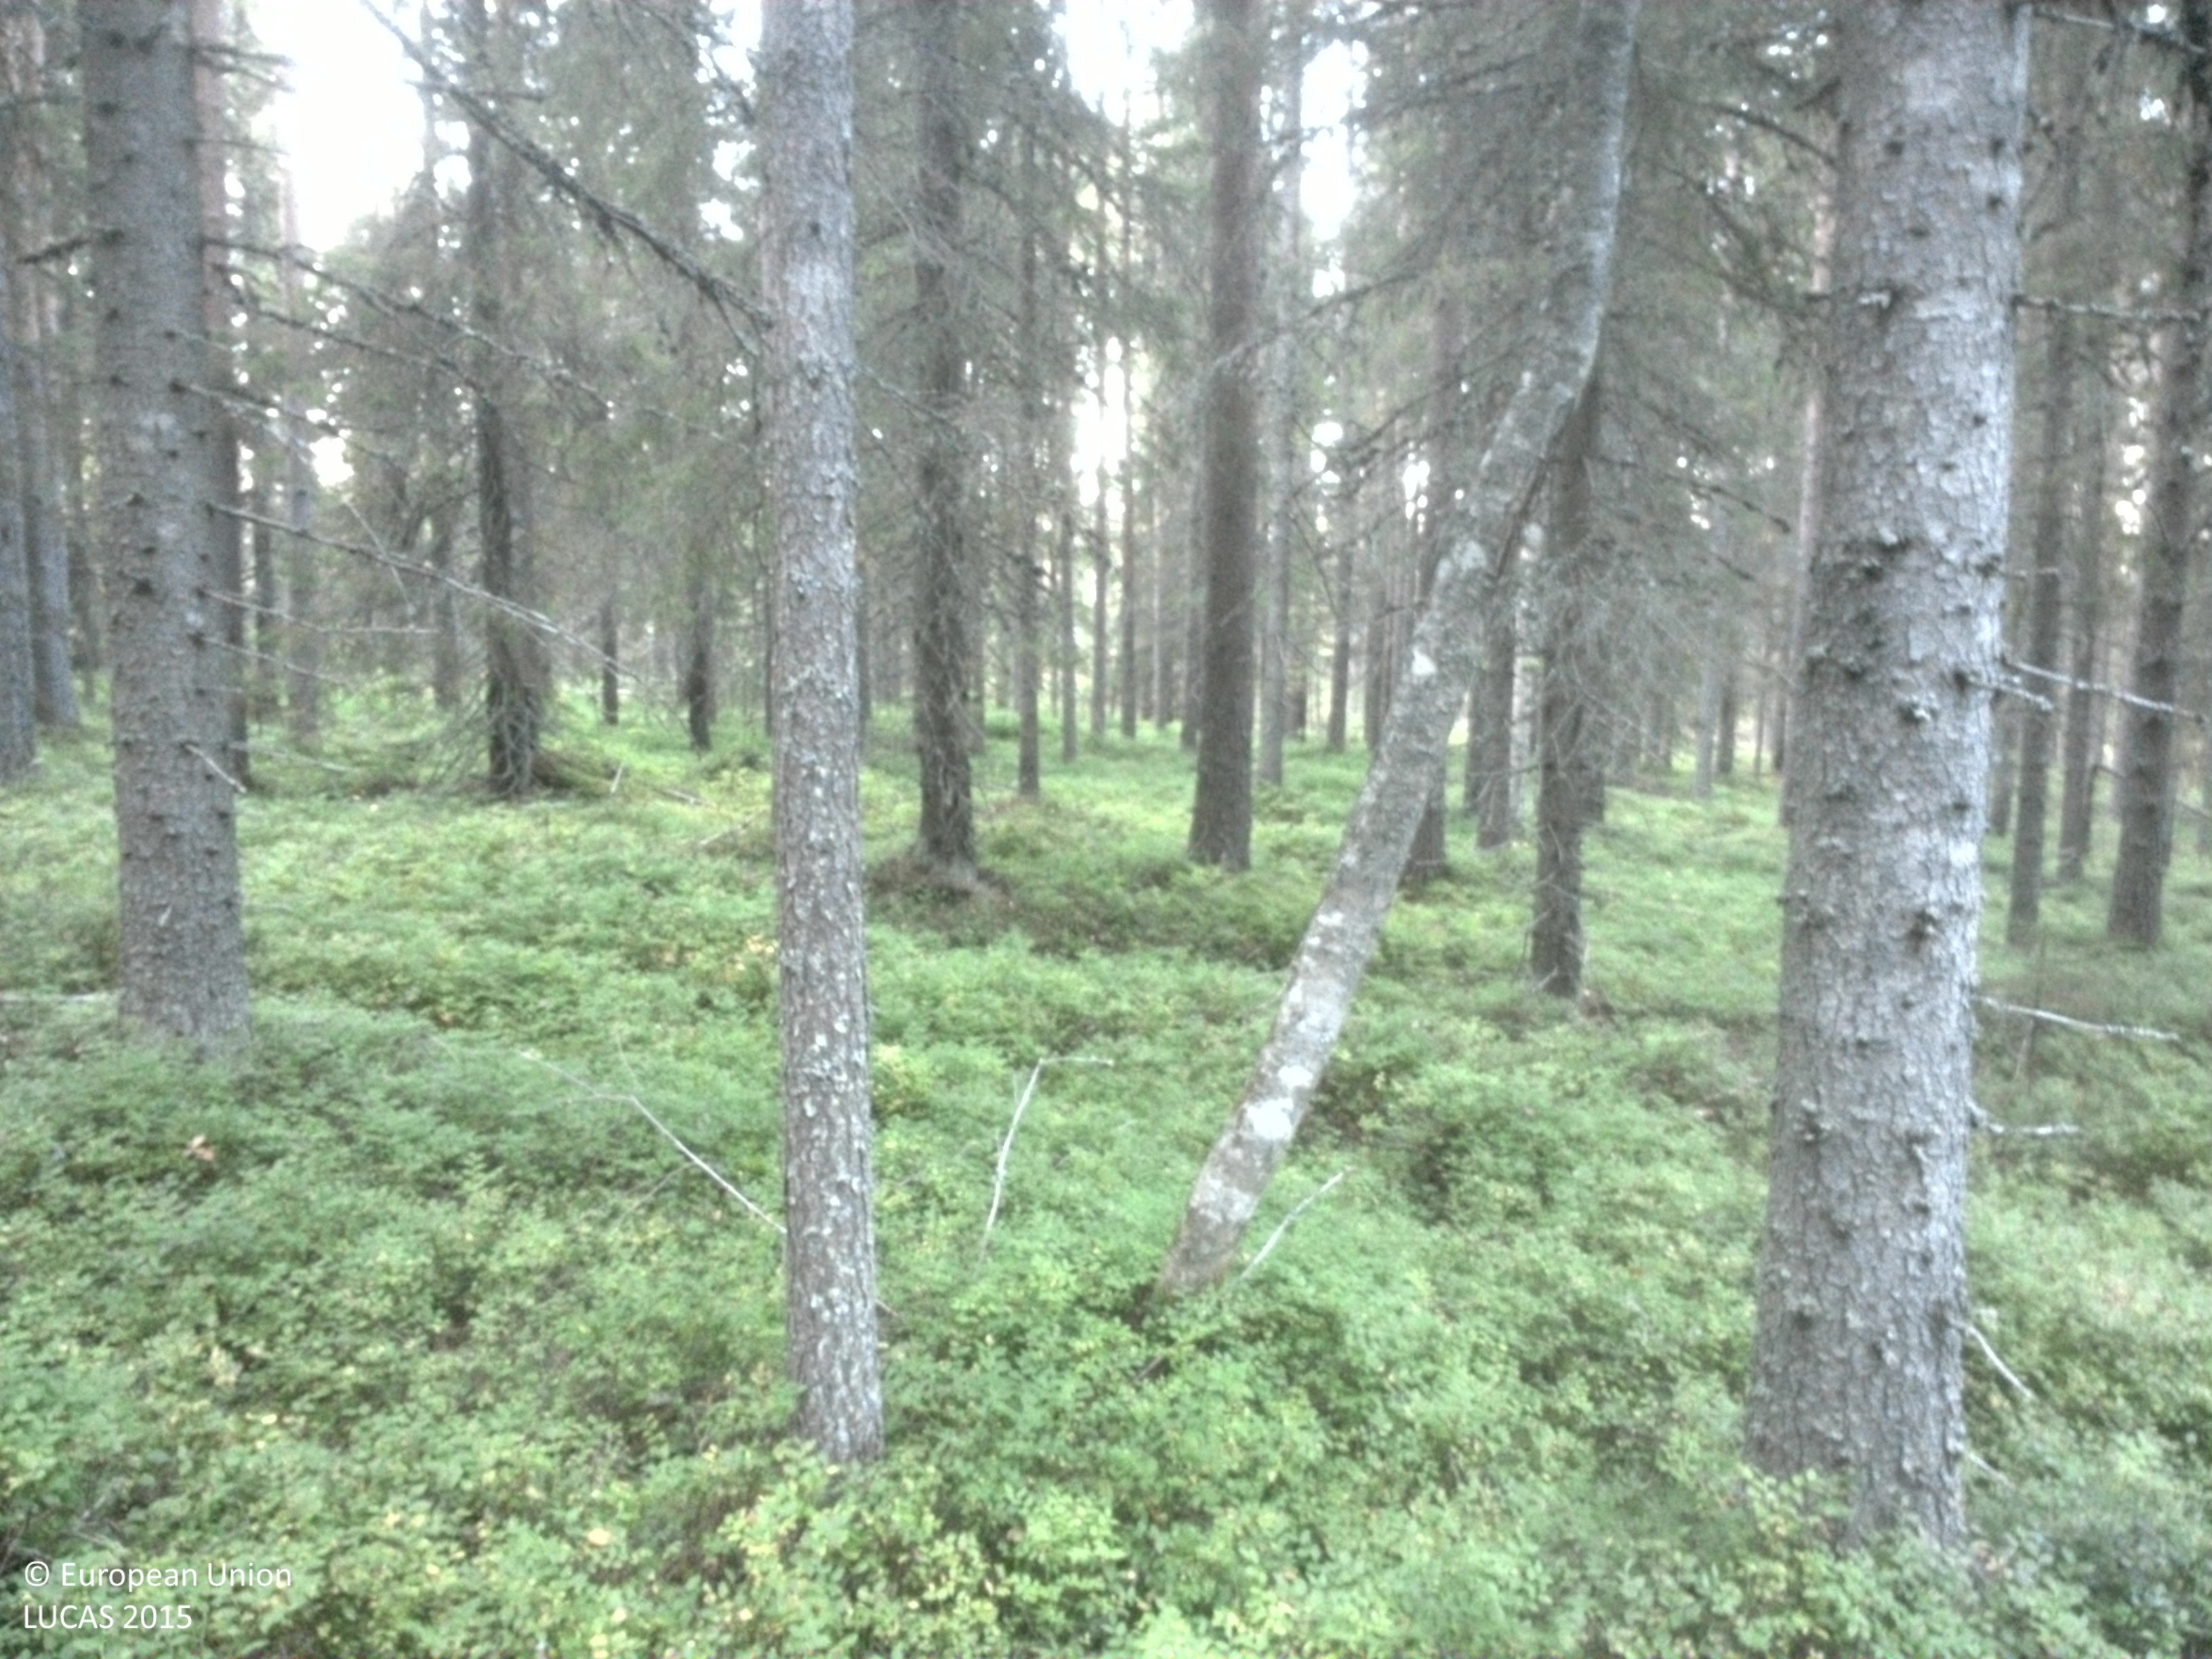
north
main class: Woodland
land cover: Spruce dominated coniferous woodland
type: boreal forest
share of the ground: 50 - 75 %
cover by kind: coniferous forest trees 75 %, shrubs 25 %
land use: Forestry
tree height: > 5 m
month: September
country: SE
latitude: 64.3402
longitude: 20.5140
